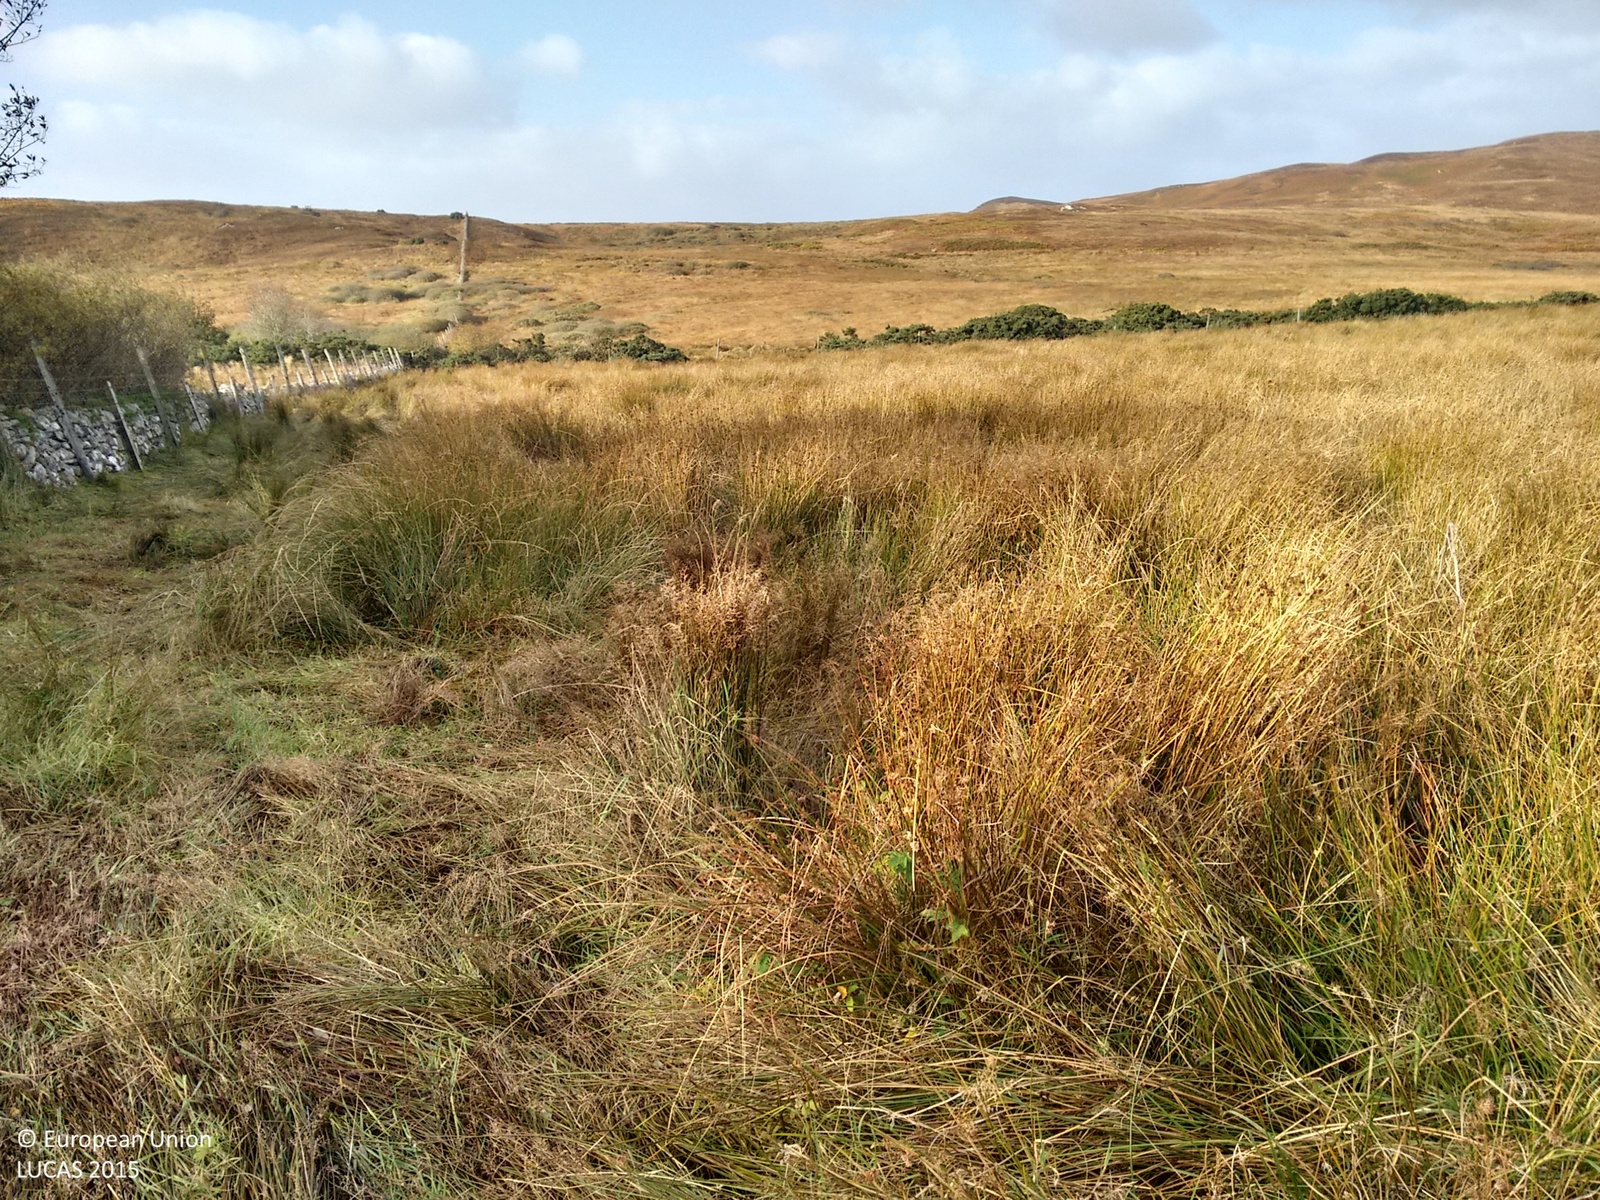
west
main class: Grassland
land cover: Grassland without tree/shrub cover
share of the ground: > 75 %
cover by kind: herbaceous plants 100 %
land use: Agriculture (excluding fallow land and kitchen gardens)
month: October
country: GB
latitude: 55.8045
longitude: -6.2412
